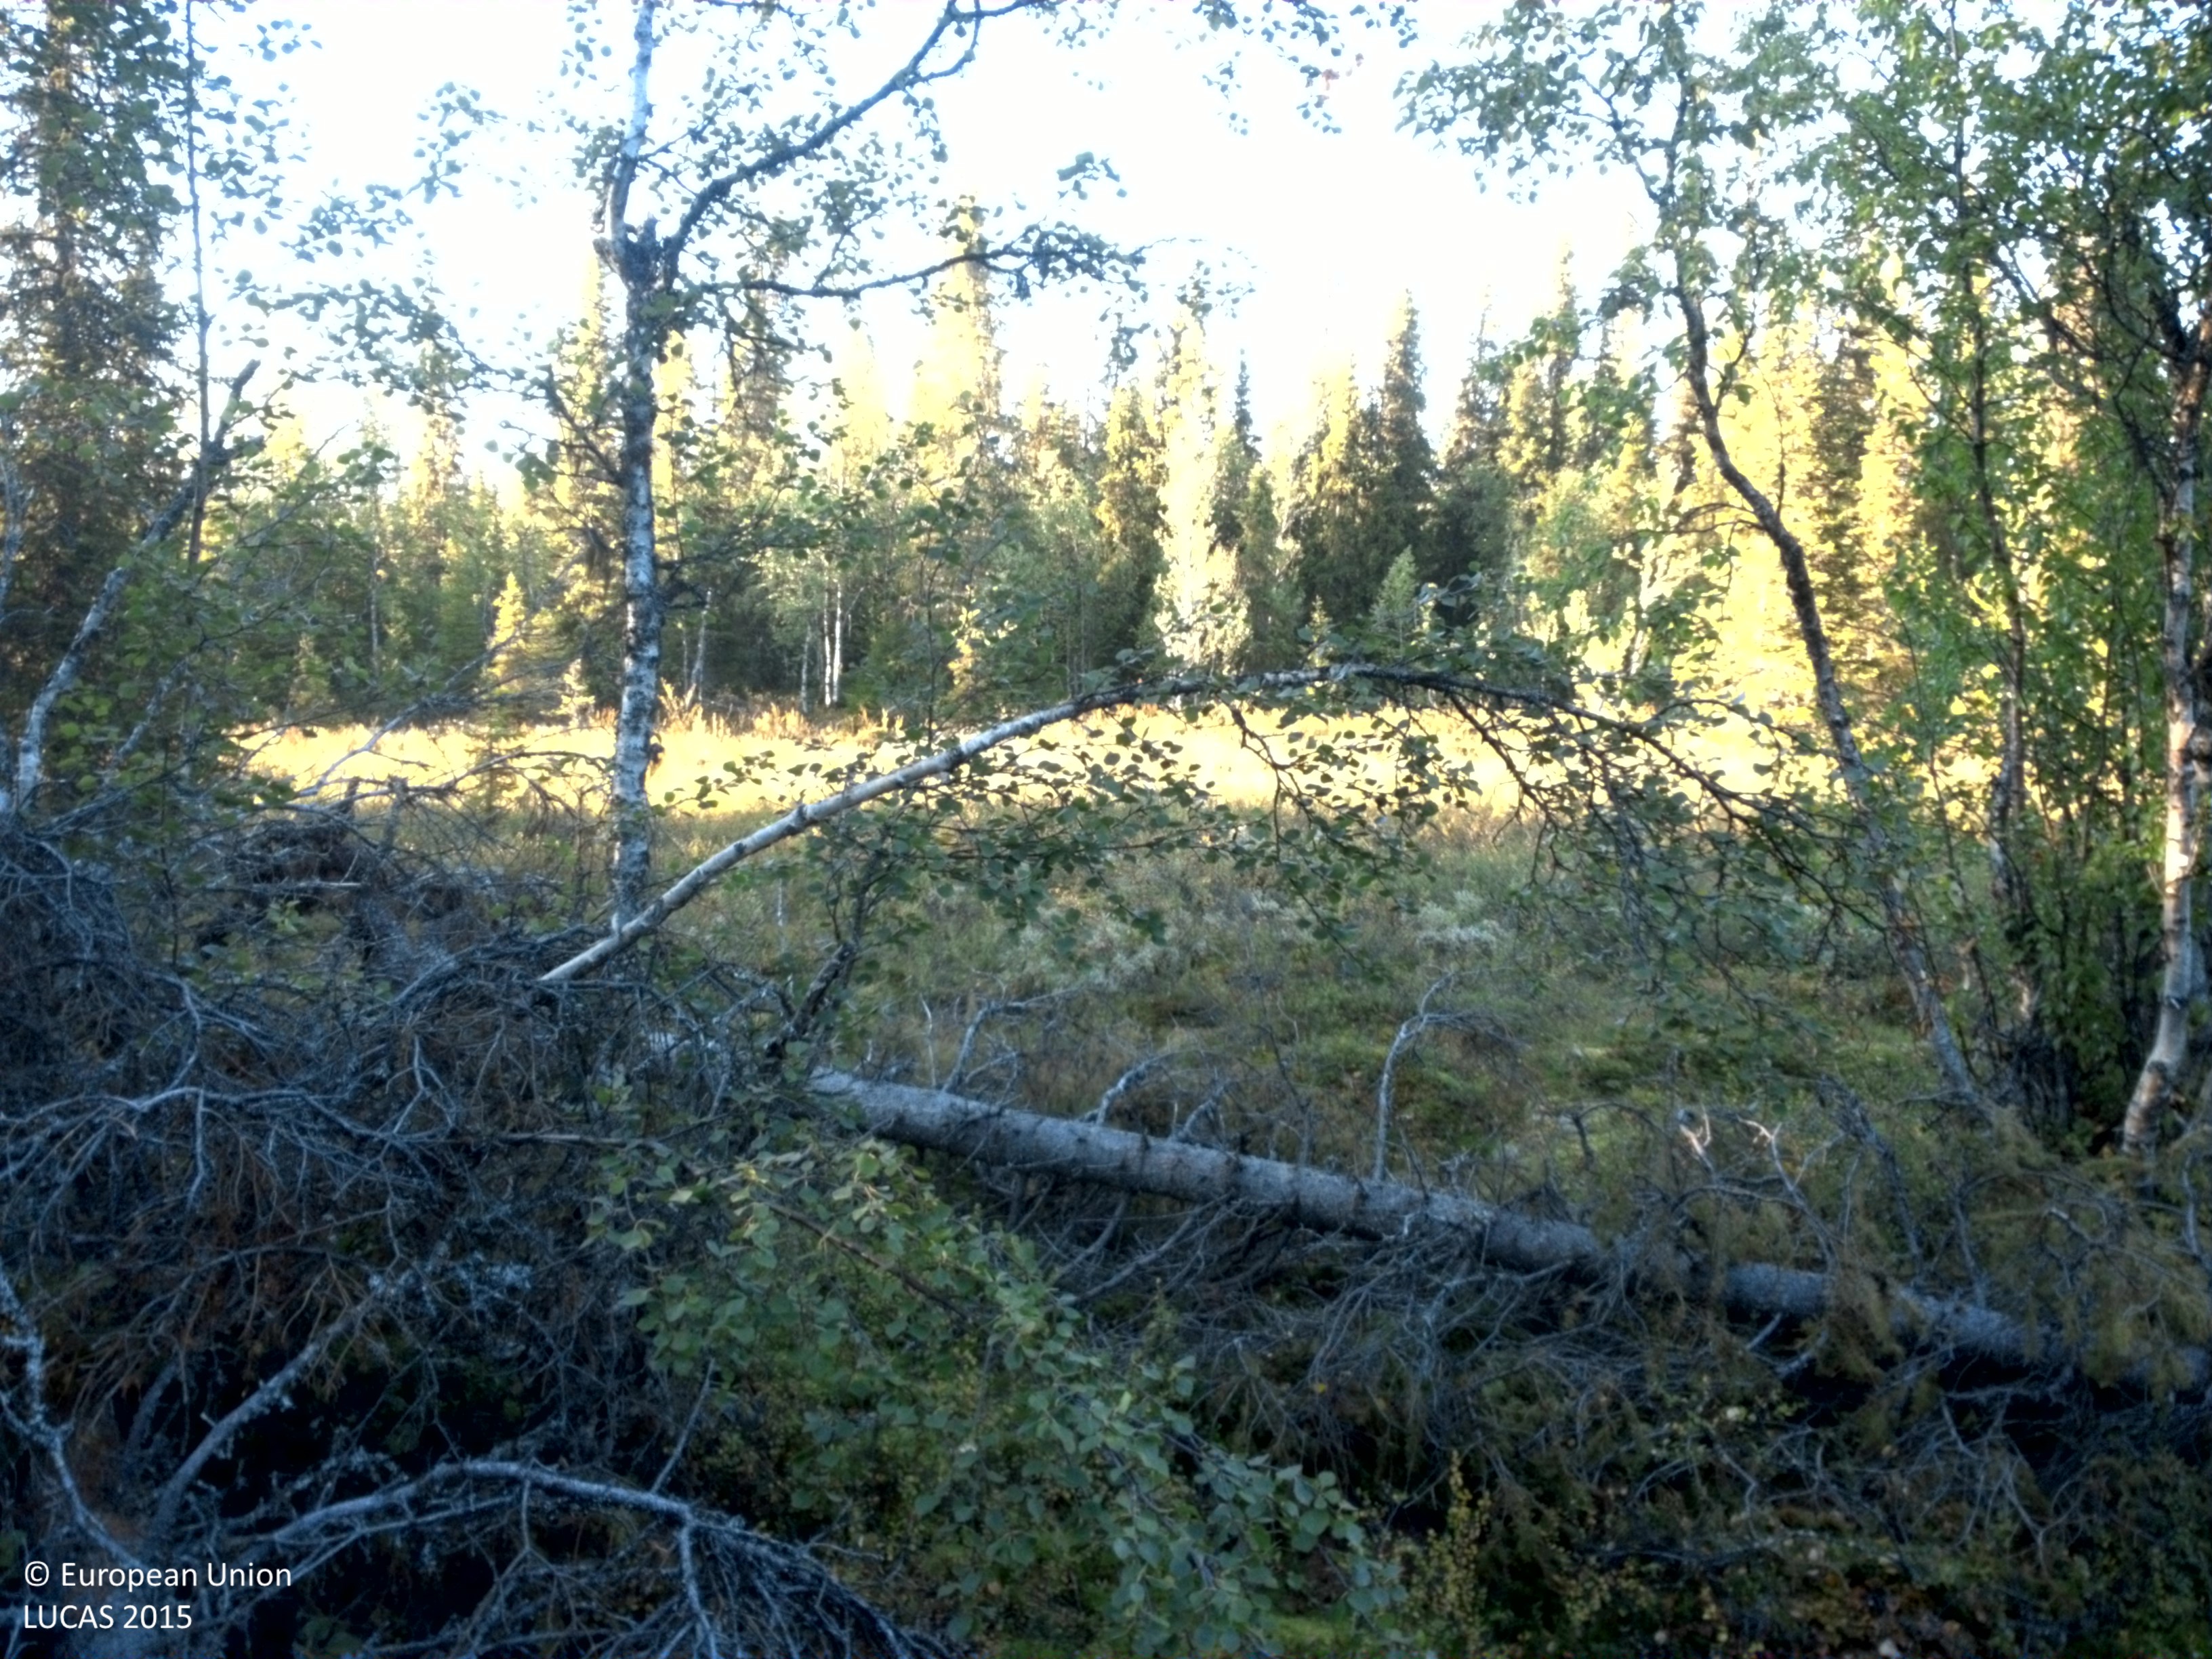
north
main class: Shrubland
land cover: Shrubland with sparse tree cover
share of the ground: 50 - 75 %
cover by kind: shrubs 50 %, lichens and mosses 35 %, herbaceous plants 10 %, broadleaved forest trees 5 %
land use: Semi-natural and natural areas not in use
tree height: > 5 m
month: September
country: SE
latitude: 65.2623
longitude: 16.0252
